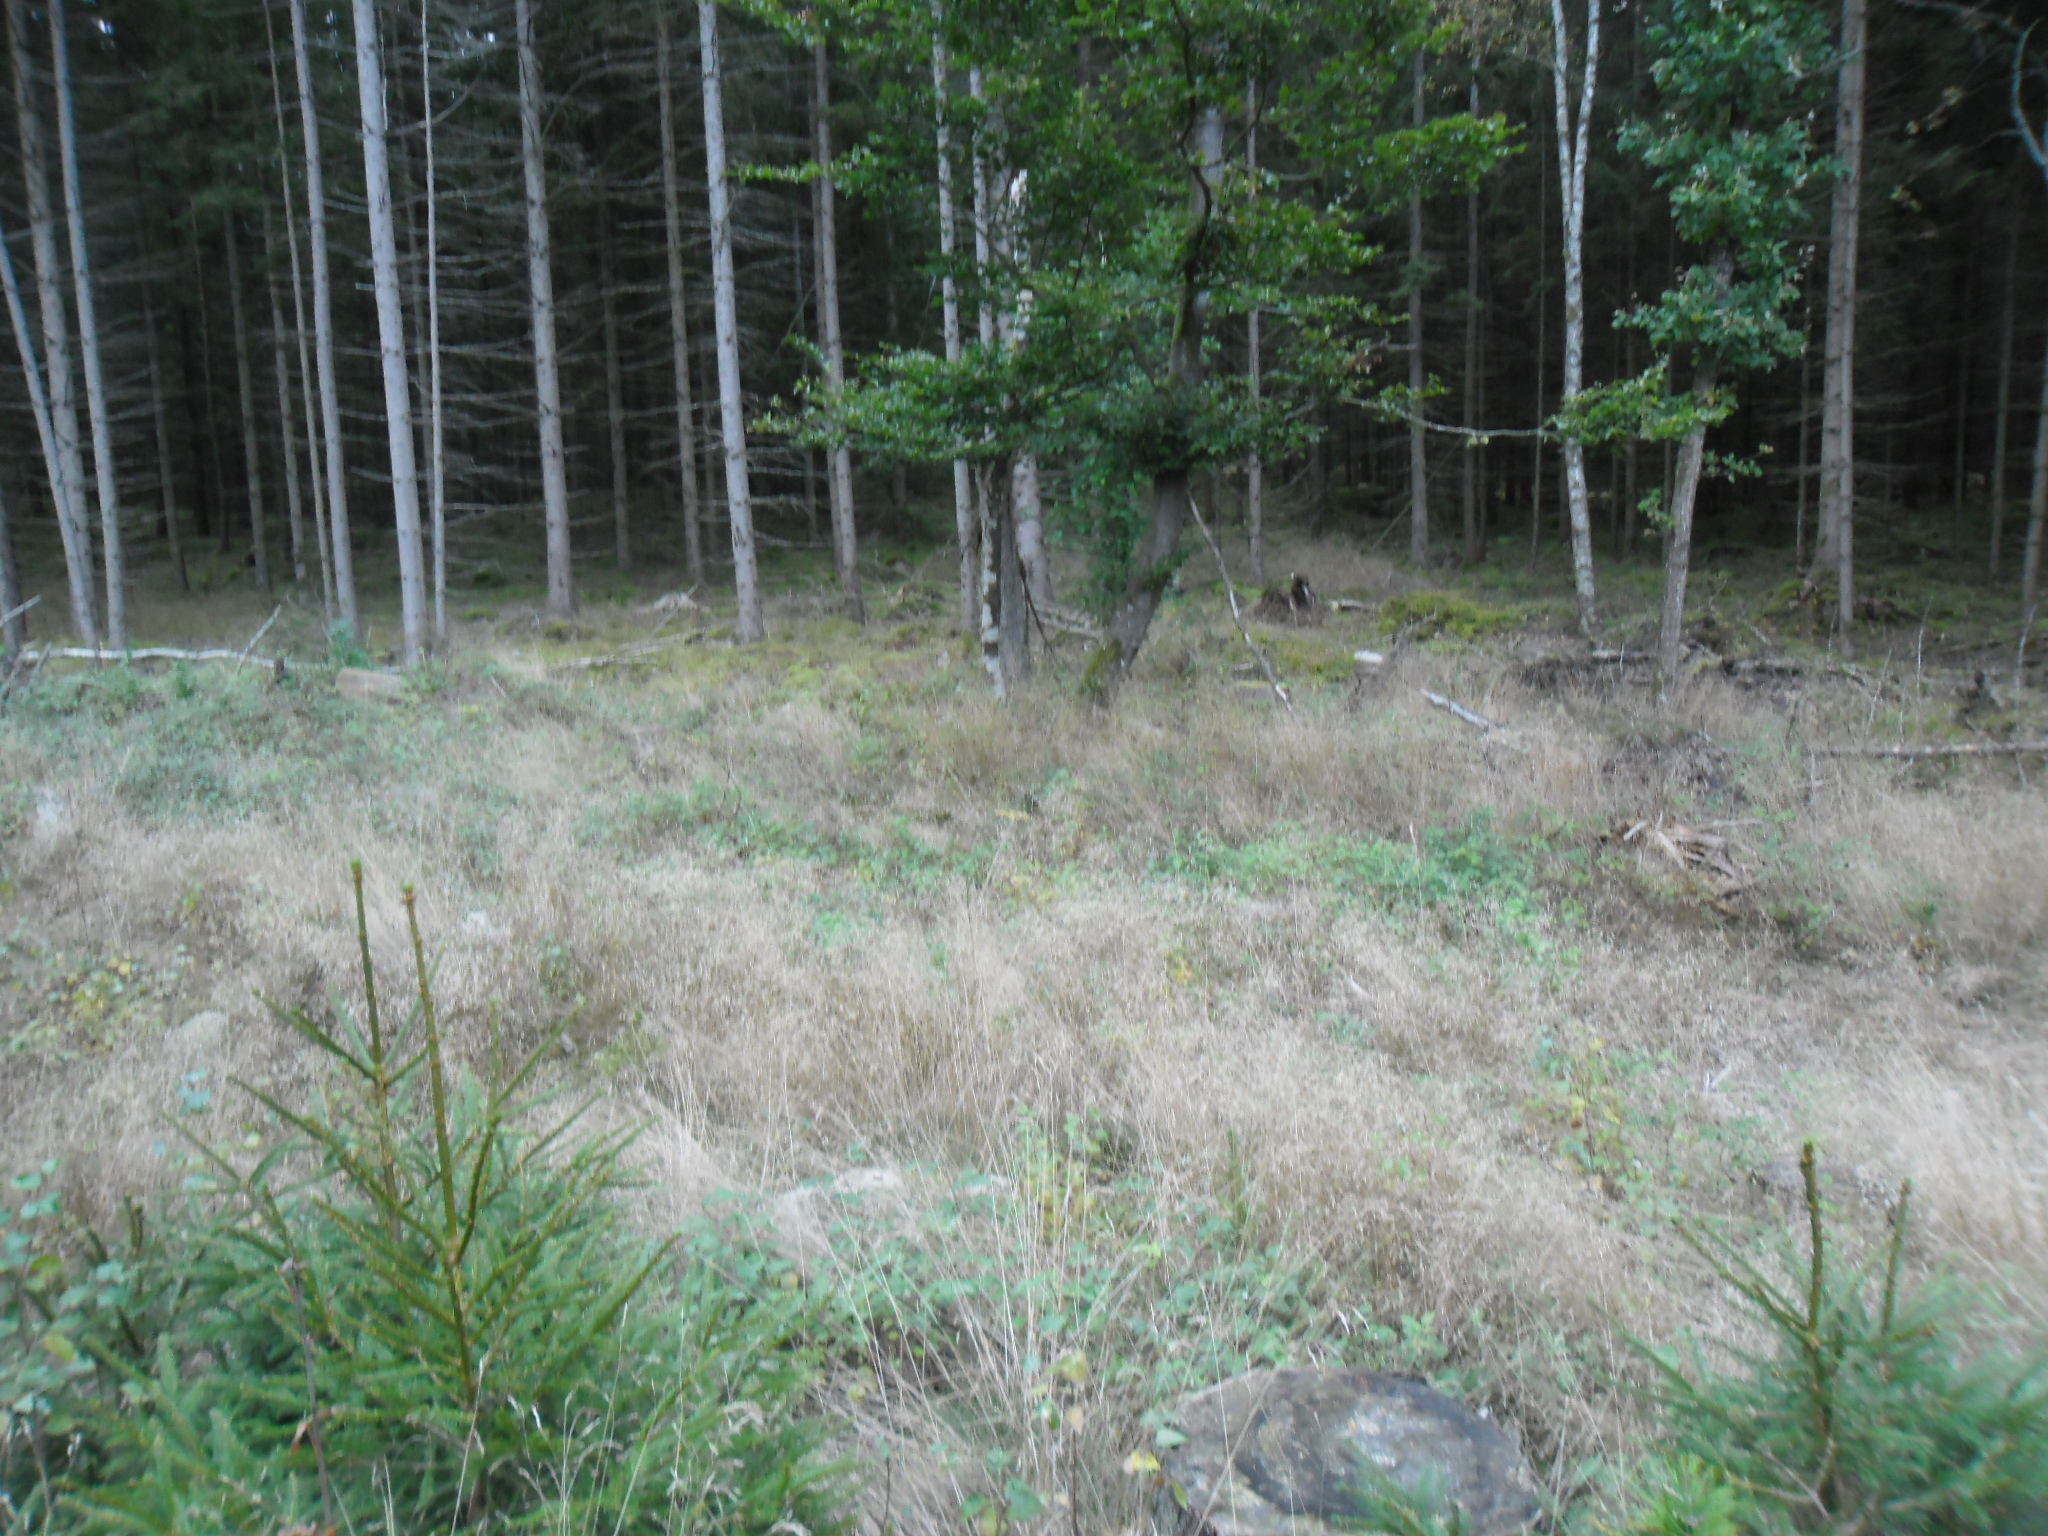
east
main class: Woodland
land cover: Spruce dominated coniferous woodland
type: boreal forest
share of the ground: > 75 %
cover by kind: coniferous forest trees 100 %
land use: Forestry
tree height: > 5 m
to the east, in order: Spruce dominated coniferous woodland; Spontaneously vegetated surfaces; Ditches and canals; Spruce dominated coniferous woodland; Tracks; Spruce dominated coniferous woodland; Ditches and canals; Spruce dominated coniferous woodland
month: October
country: SE
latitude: 56.3674
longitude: 13.7368
